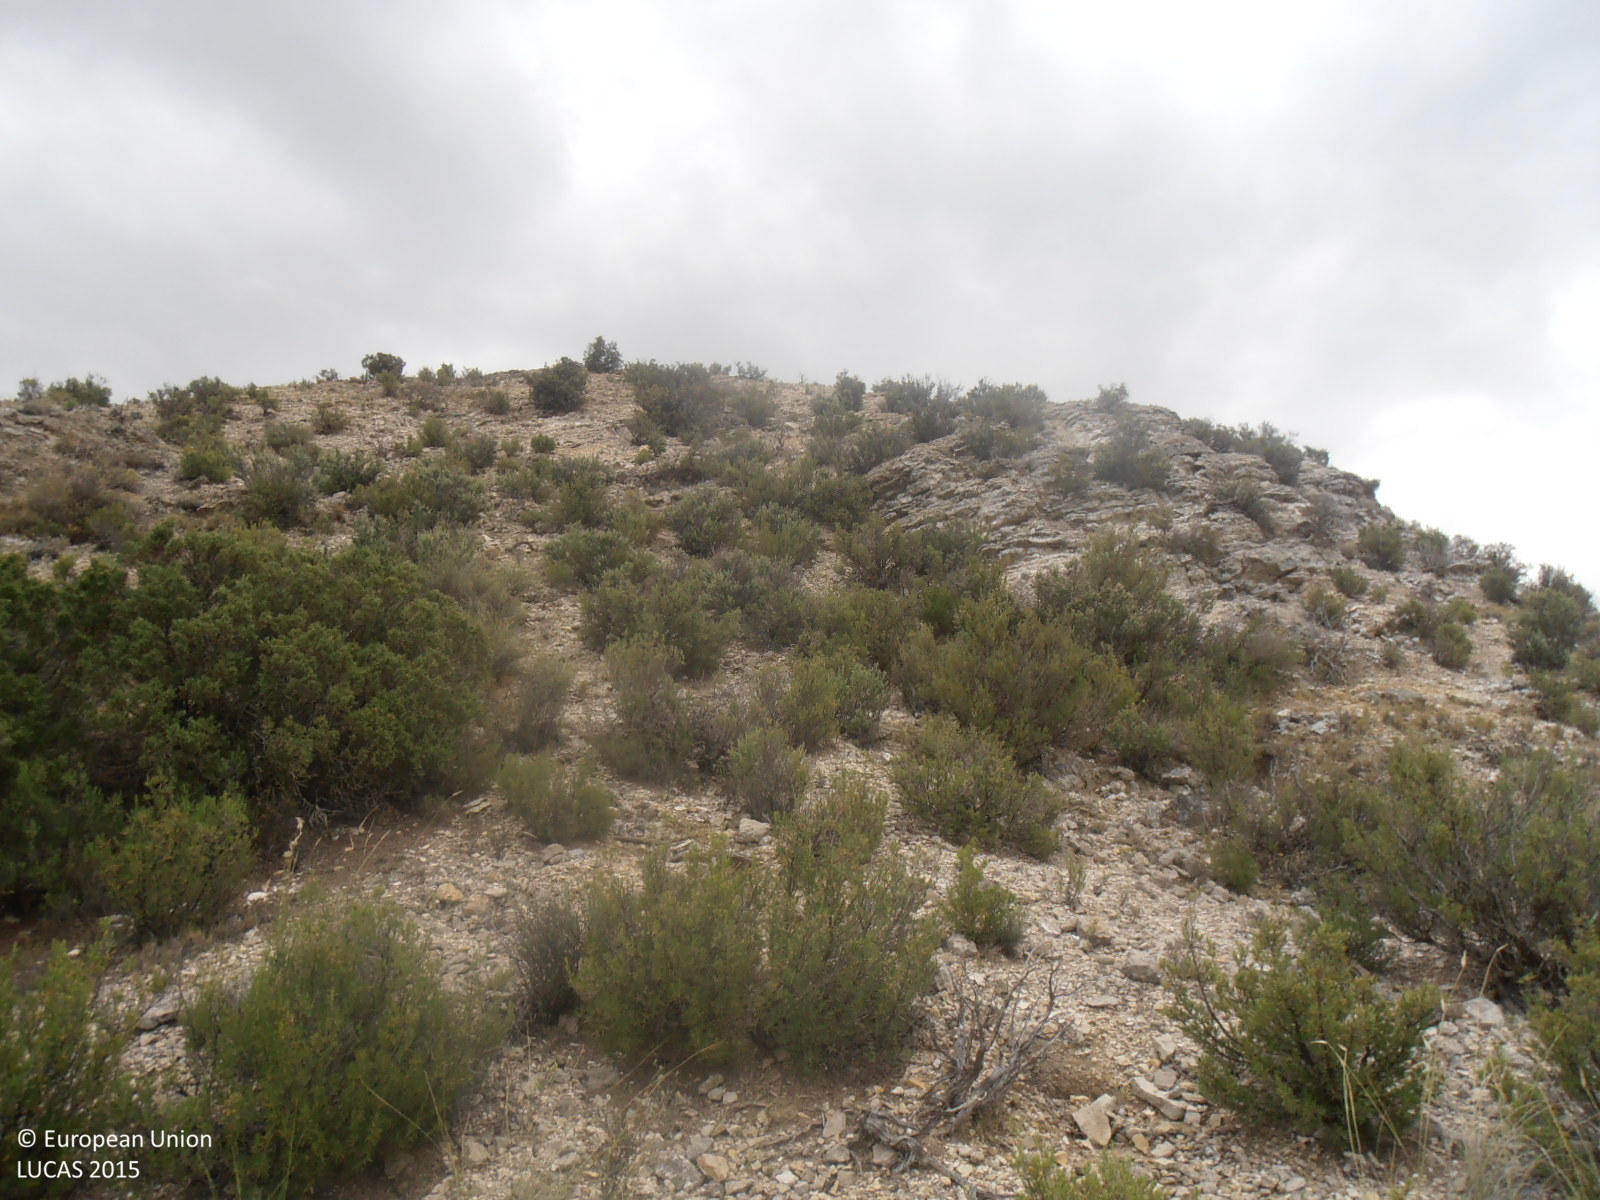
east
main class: Shrubland
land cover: Shrubland without tree cover
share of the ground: 50 - 75 %
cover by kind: shrubs 55 %, consolidated bare surface 45 %
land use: Semi-natural and natural areas not in use
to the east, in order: Shrubland without tree cover; Tracks; Shruby margins; Other bare soil; Shrubland without tree cover; Other bare soil; Shrubland without tree cover; Other bare soil
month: June
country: ES
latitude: 41.9069
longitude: -0.8373
